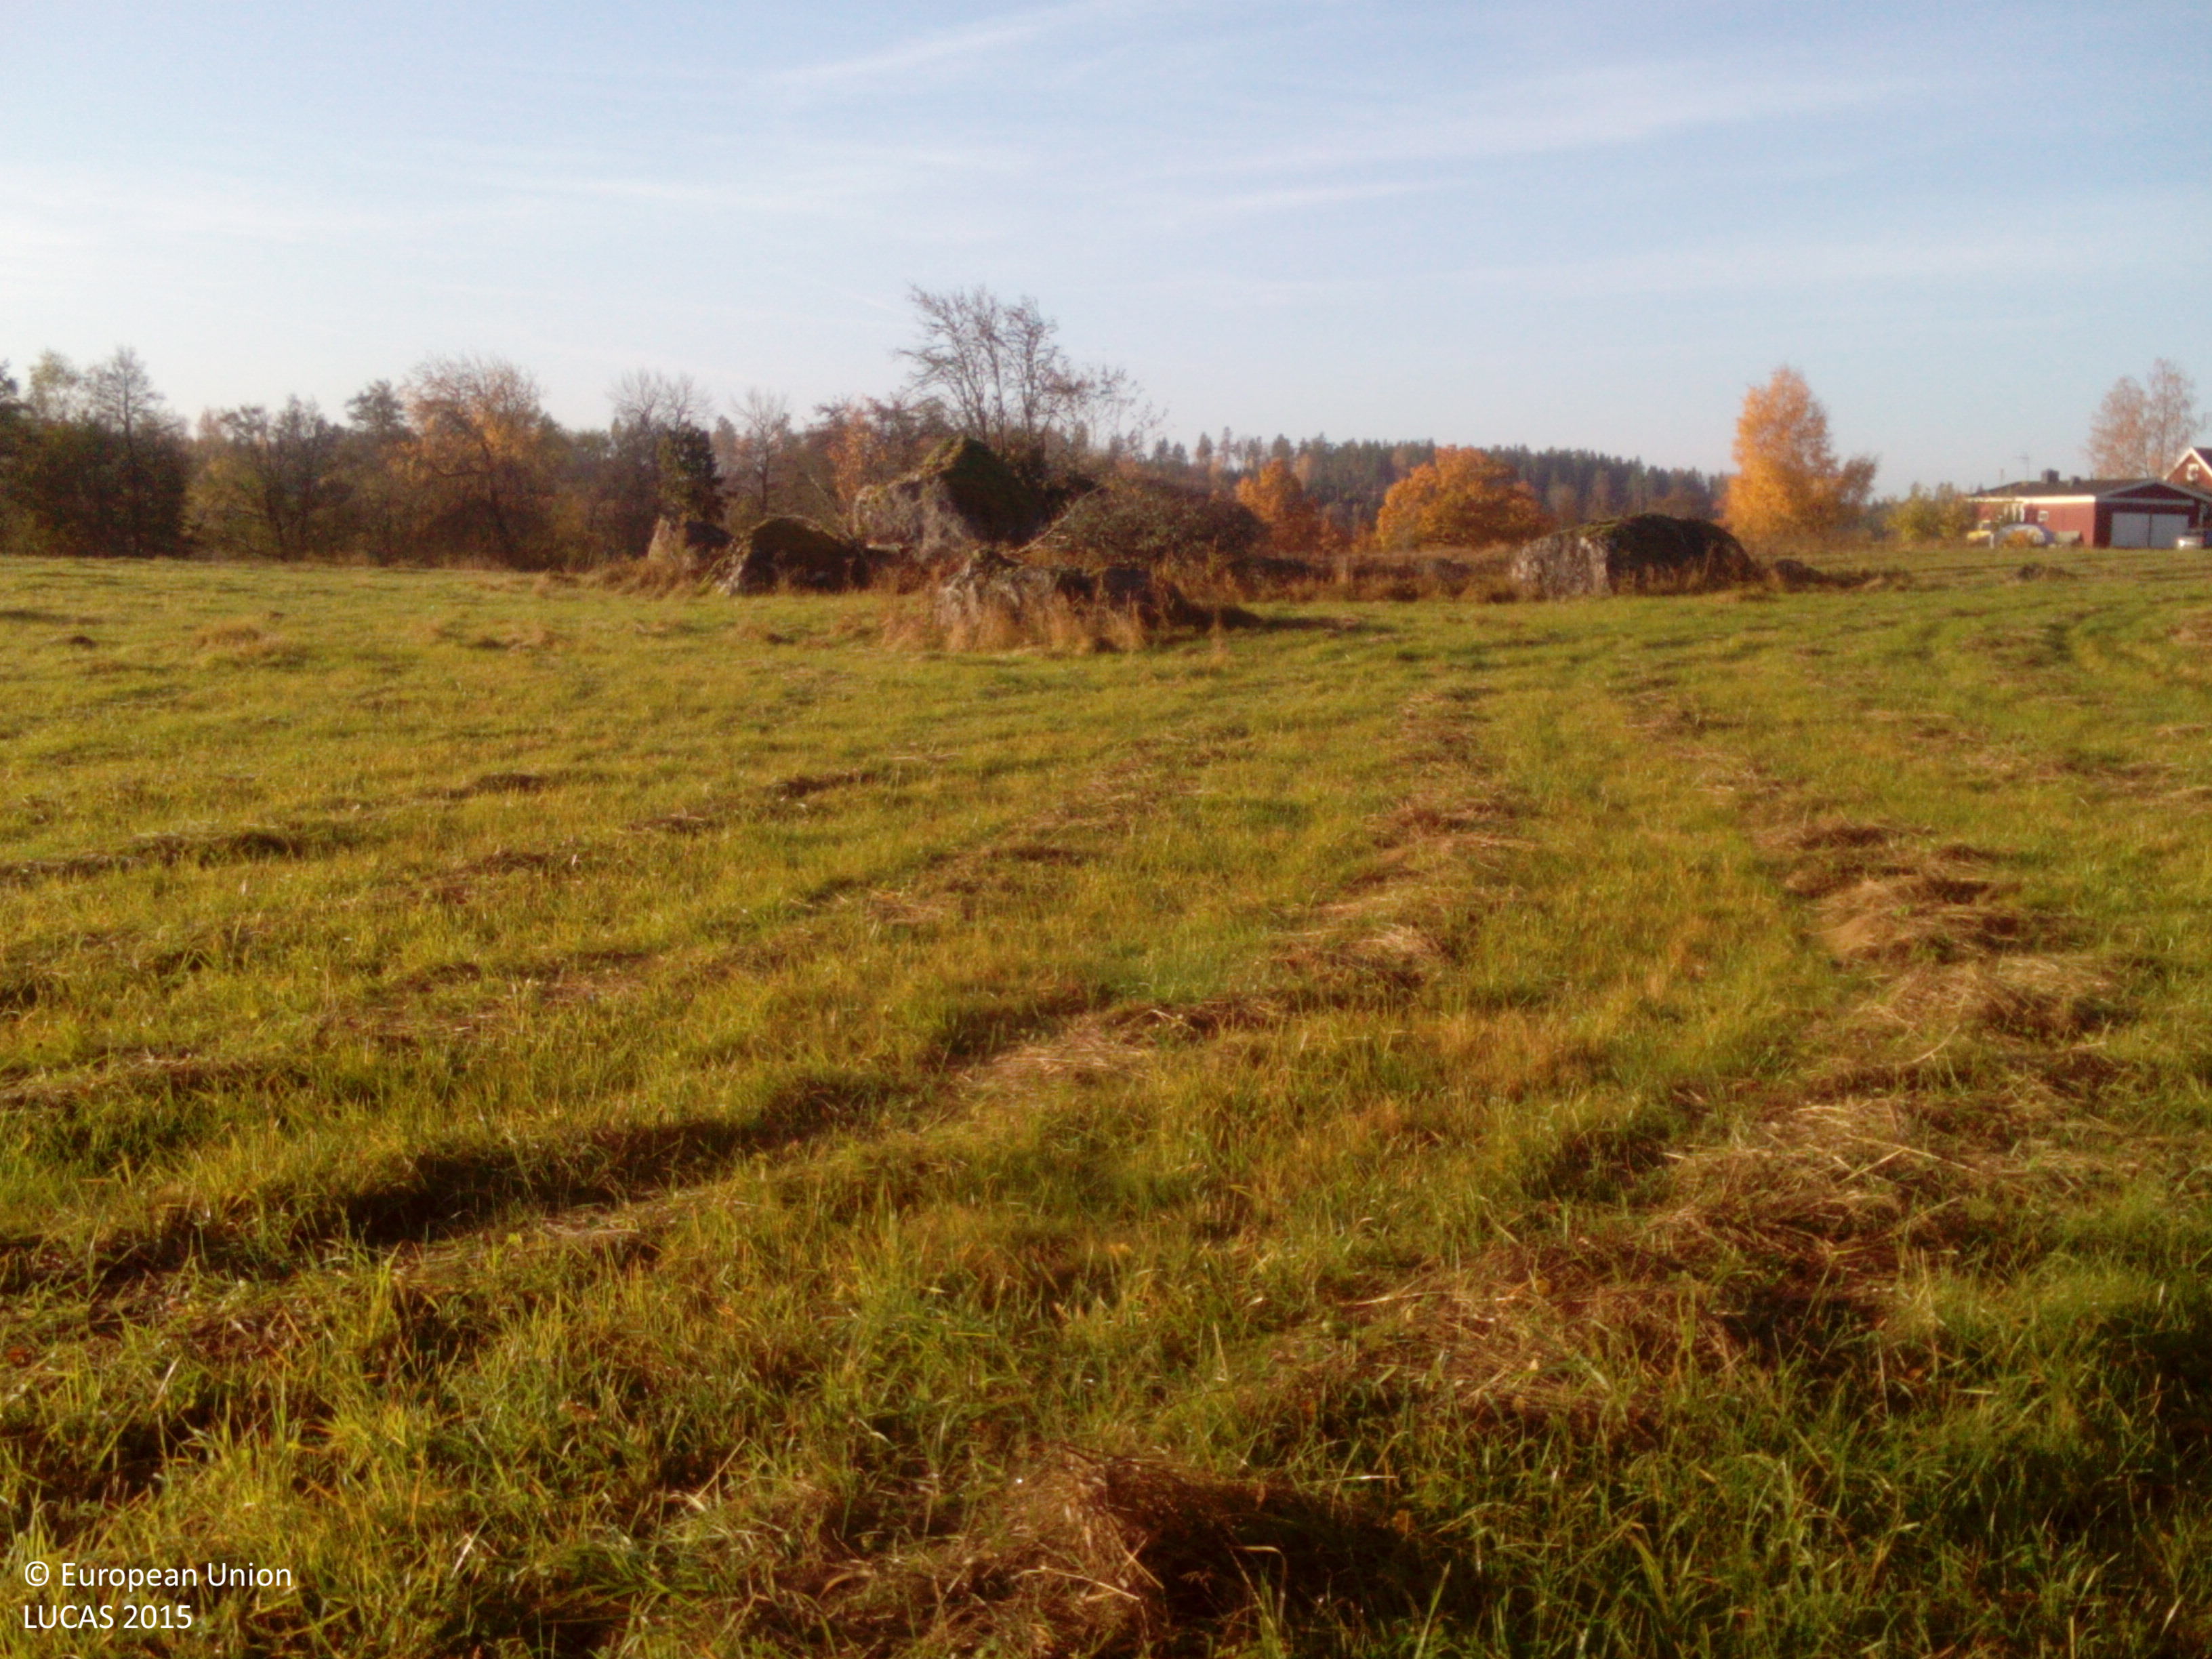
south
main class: Grassland
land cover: Grassland without tree/shrub cover
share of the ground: > 75 %
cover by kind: herbaceous plants 100 %
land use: Agriculture (excluding fallow land and kitchen gardens)
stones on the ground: < 10 %
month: October
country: SE
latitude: 59.0555
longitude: 16.4976
